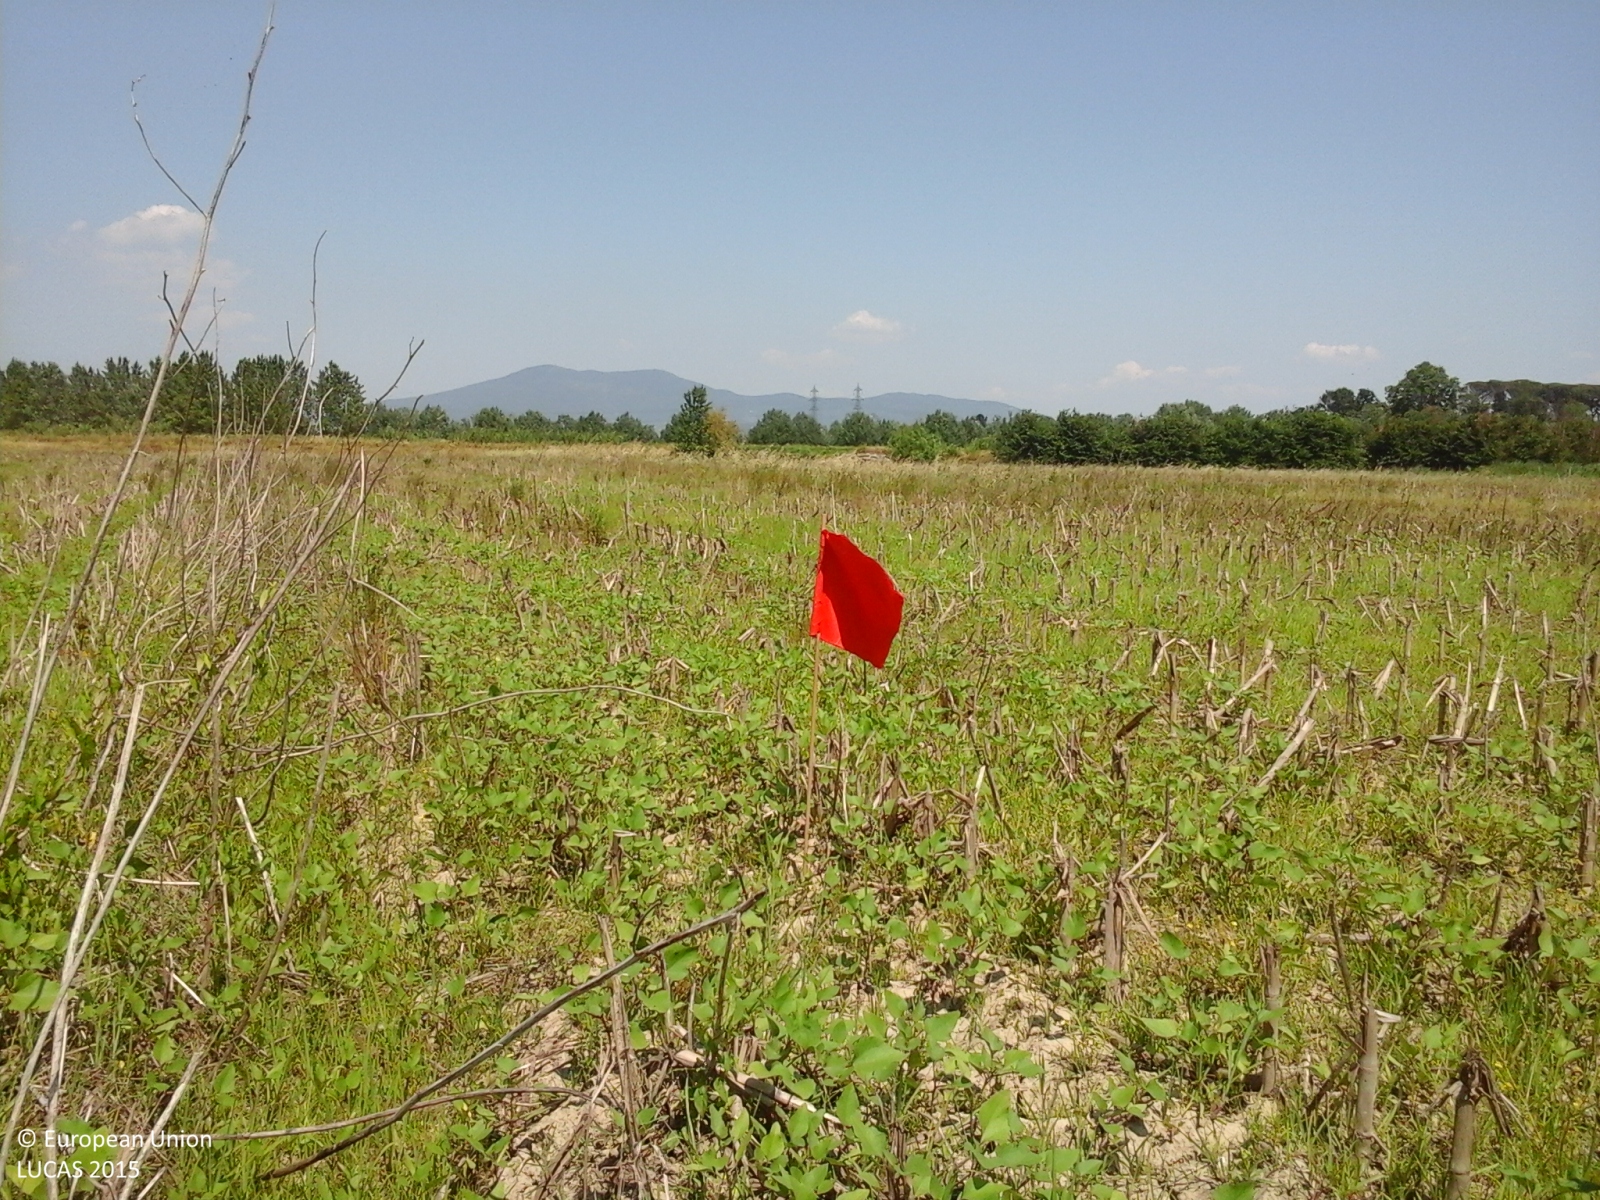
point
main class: Grassland
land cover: Spontaneously vegetated surfaces
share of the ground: > 75 %
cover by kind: herbaceous plants 100 %
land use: Agriculture (excluding fallow land and kitchen gardens)
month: June
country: IT
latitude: 43.8220
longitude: 11.0541
